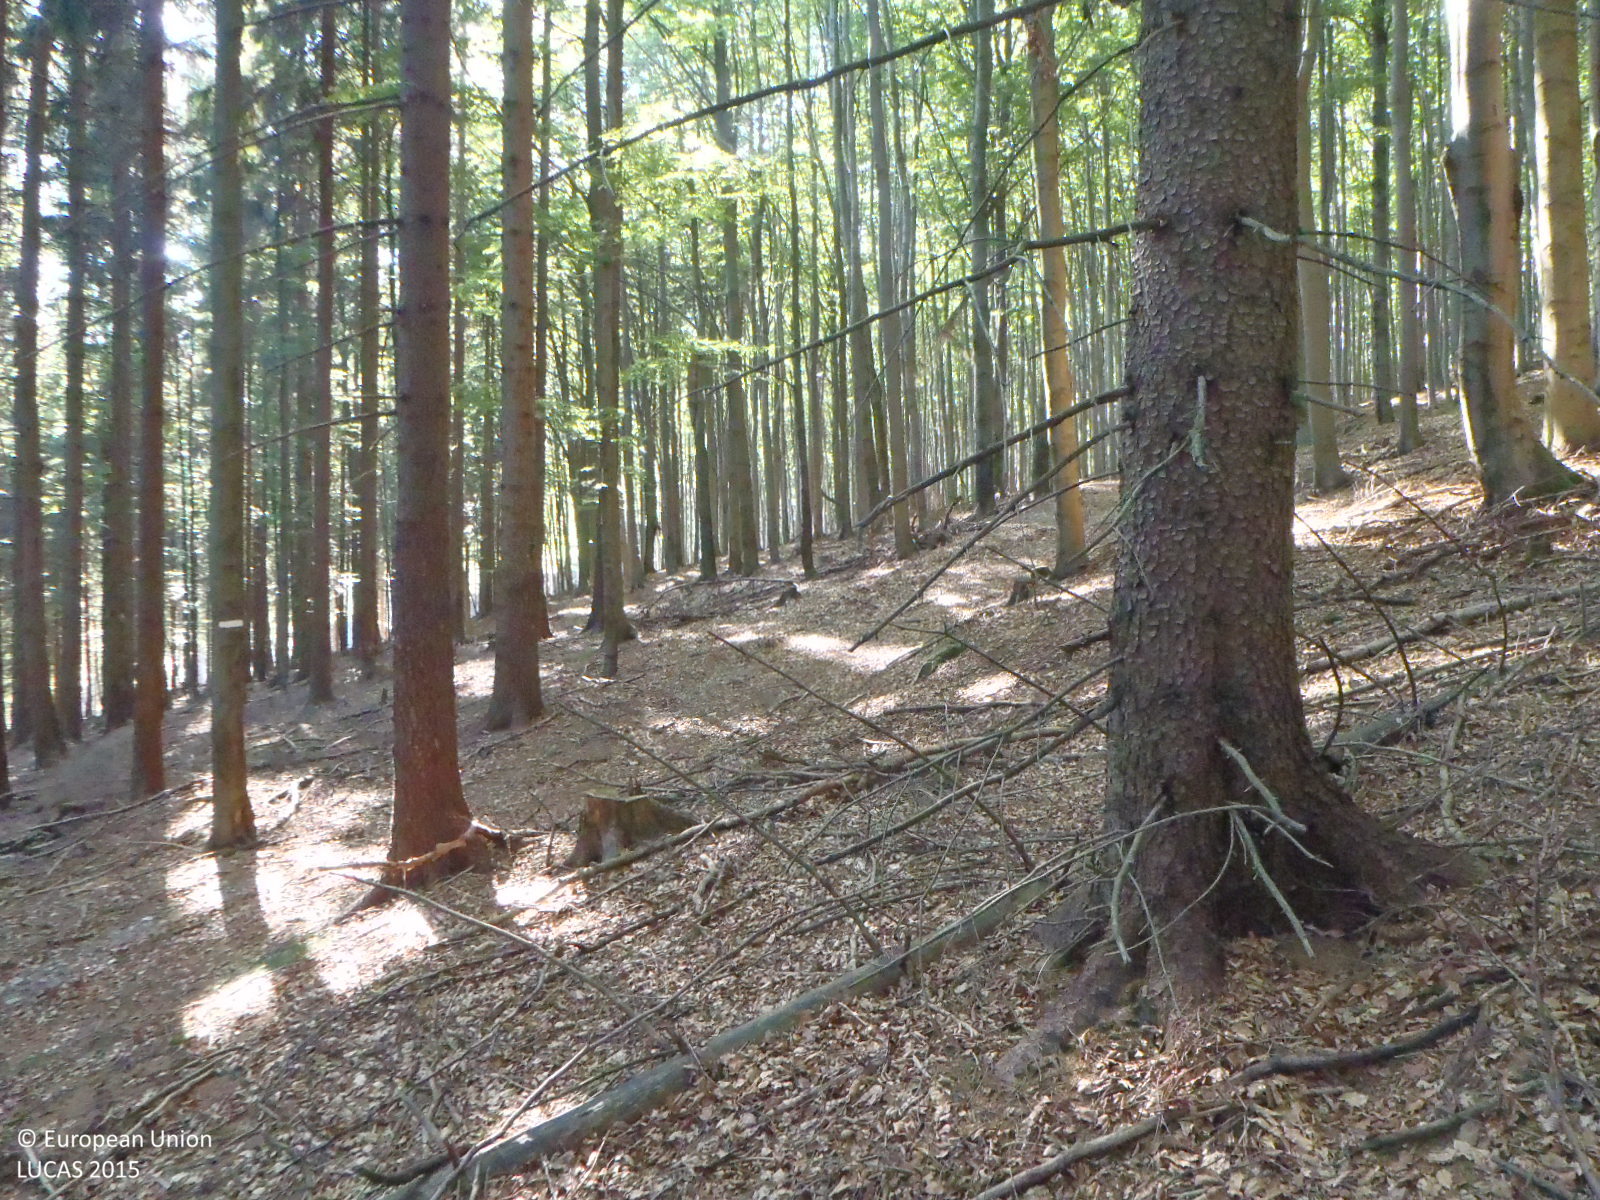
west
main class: Woodland
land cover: Spruce dominated mixed woodland
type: hemiboreal forest and nemoral coniferous forest and mixed broadleaved-coniferous forest
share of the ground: > 75 %
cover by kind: coniferous forest trees 50 %, broadleaved forest trees 50 %
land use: Forestry
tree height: > 5 m
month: August
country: CZ
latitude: 50.8315
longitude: 14.5596
